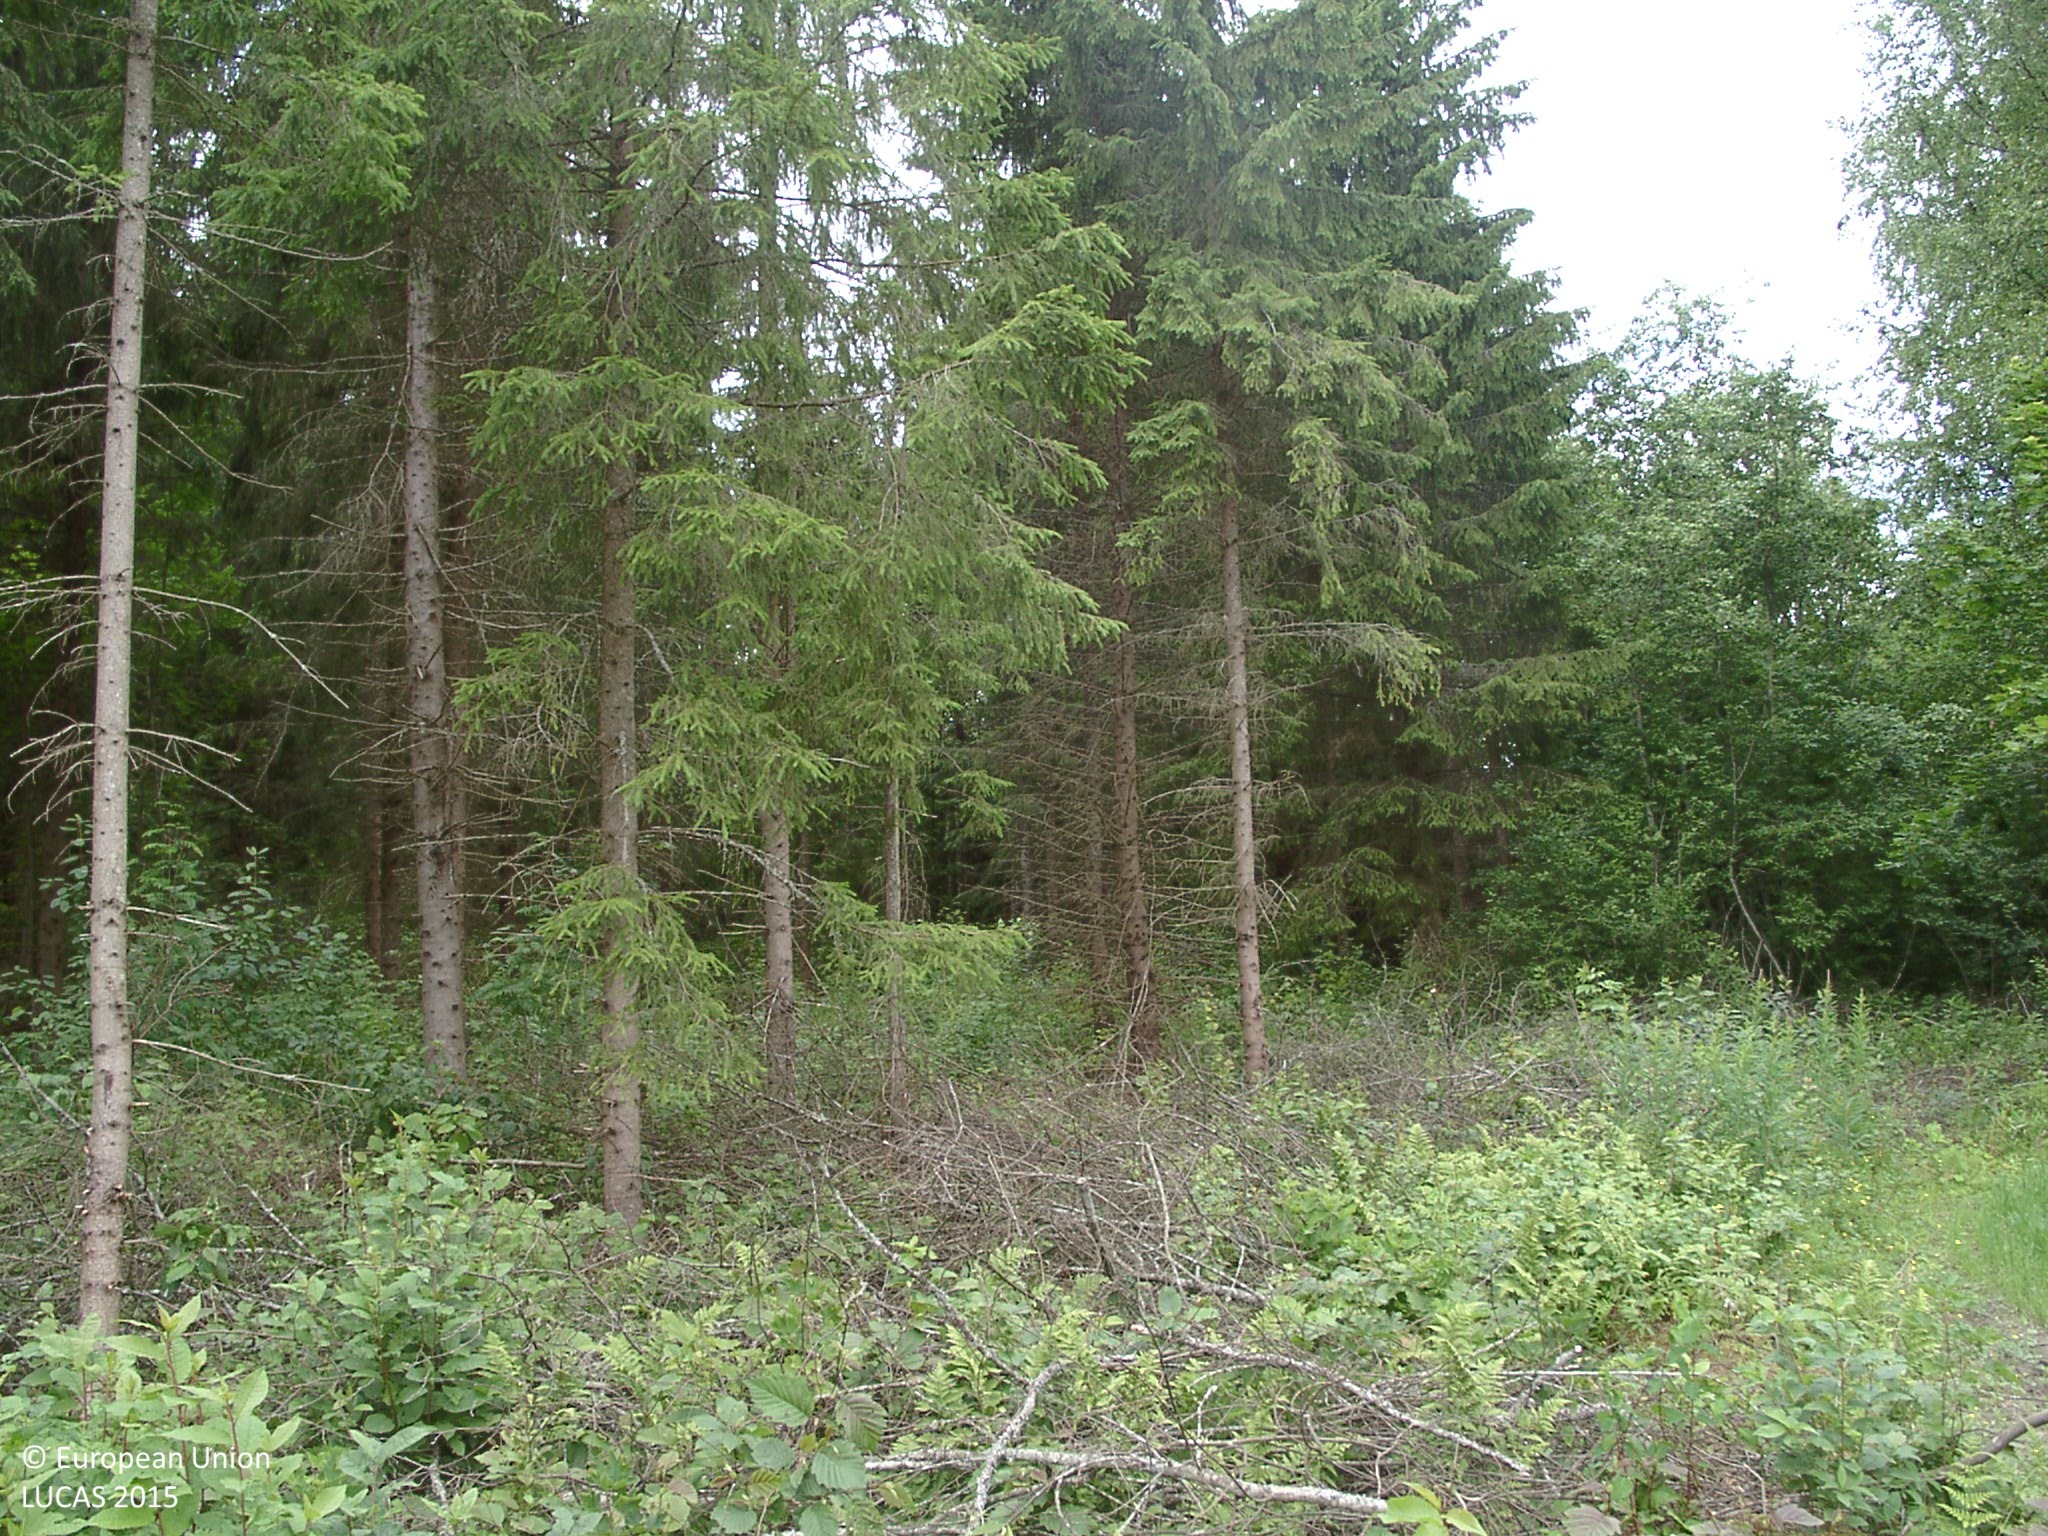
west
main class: Woodland
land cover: Broadleaved woodland
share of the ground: 25 - 50 %
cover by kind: broadleaved forest trees 45 %, herbaceous plants 10 %, shrubs 5 %, lichens and mosses 5 %
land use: Semi-natural and natural areas not in use
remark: Nursery
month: July
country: FI
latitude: 61.5236
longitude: 25.1727
